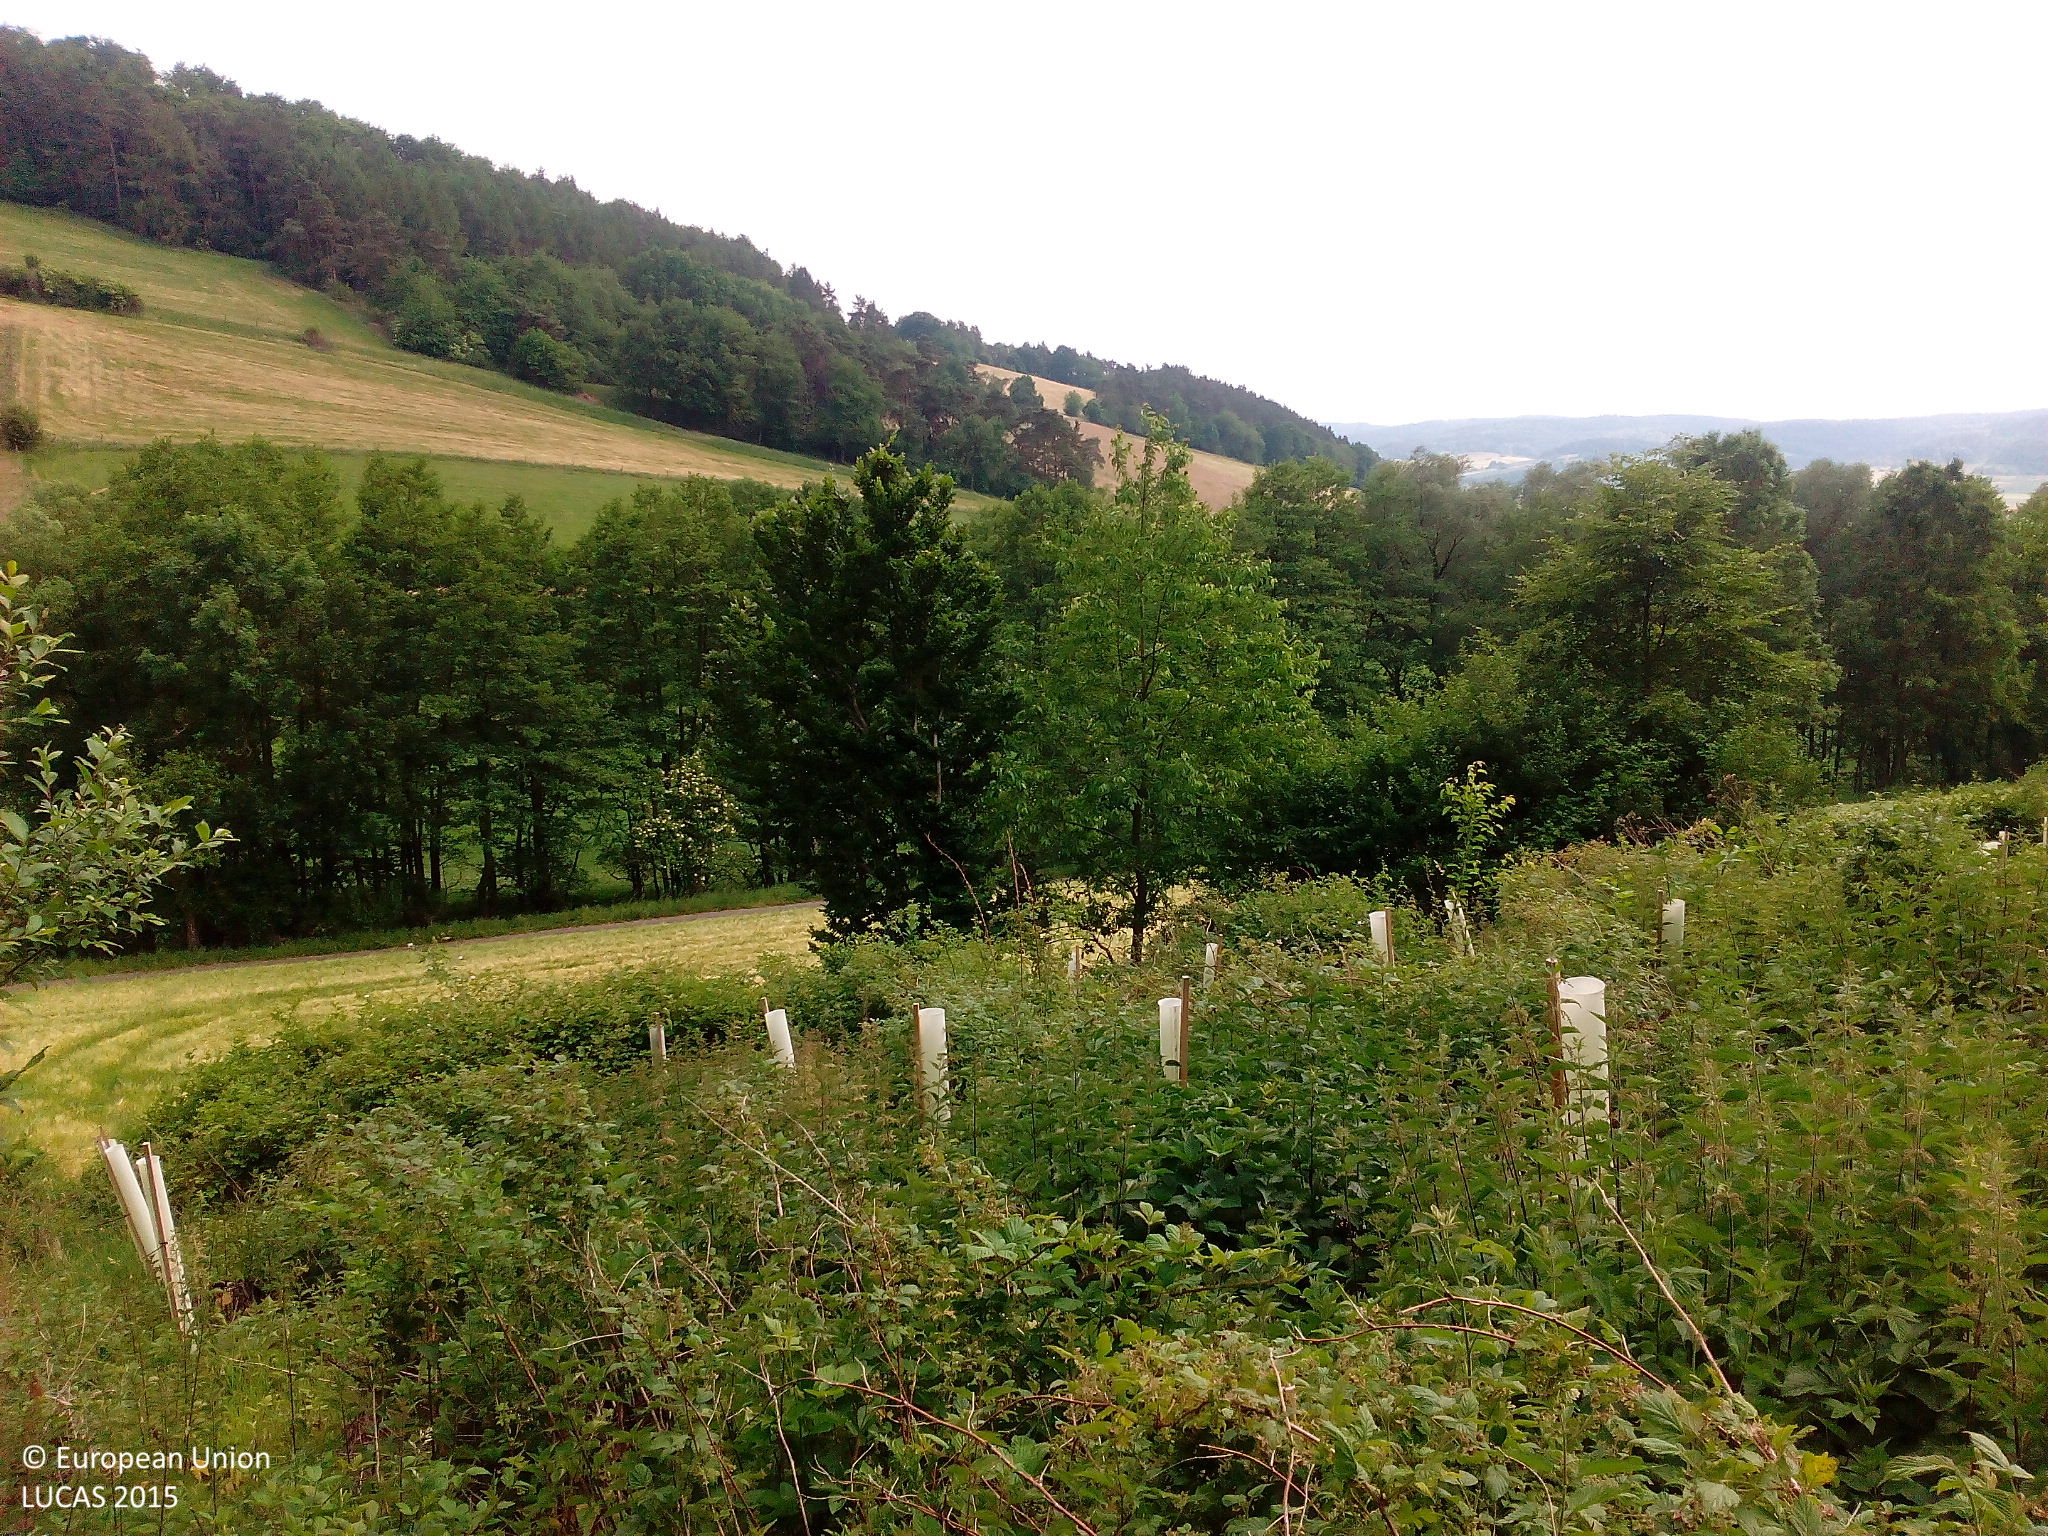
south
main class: Shrubland
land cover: Shrubland with sparse tree cover
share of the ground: > 75 %
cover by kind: herbaceous plants 55 %, shrubs 40 %, broadleaved forest trees 5 %
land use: Forestry
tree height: < 5 m
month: June
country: DE
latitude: 51.0647
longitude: 9.6434
